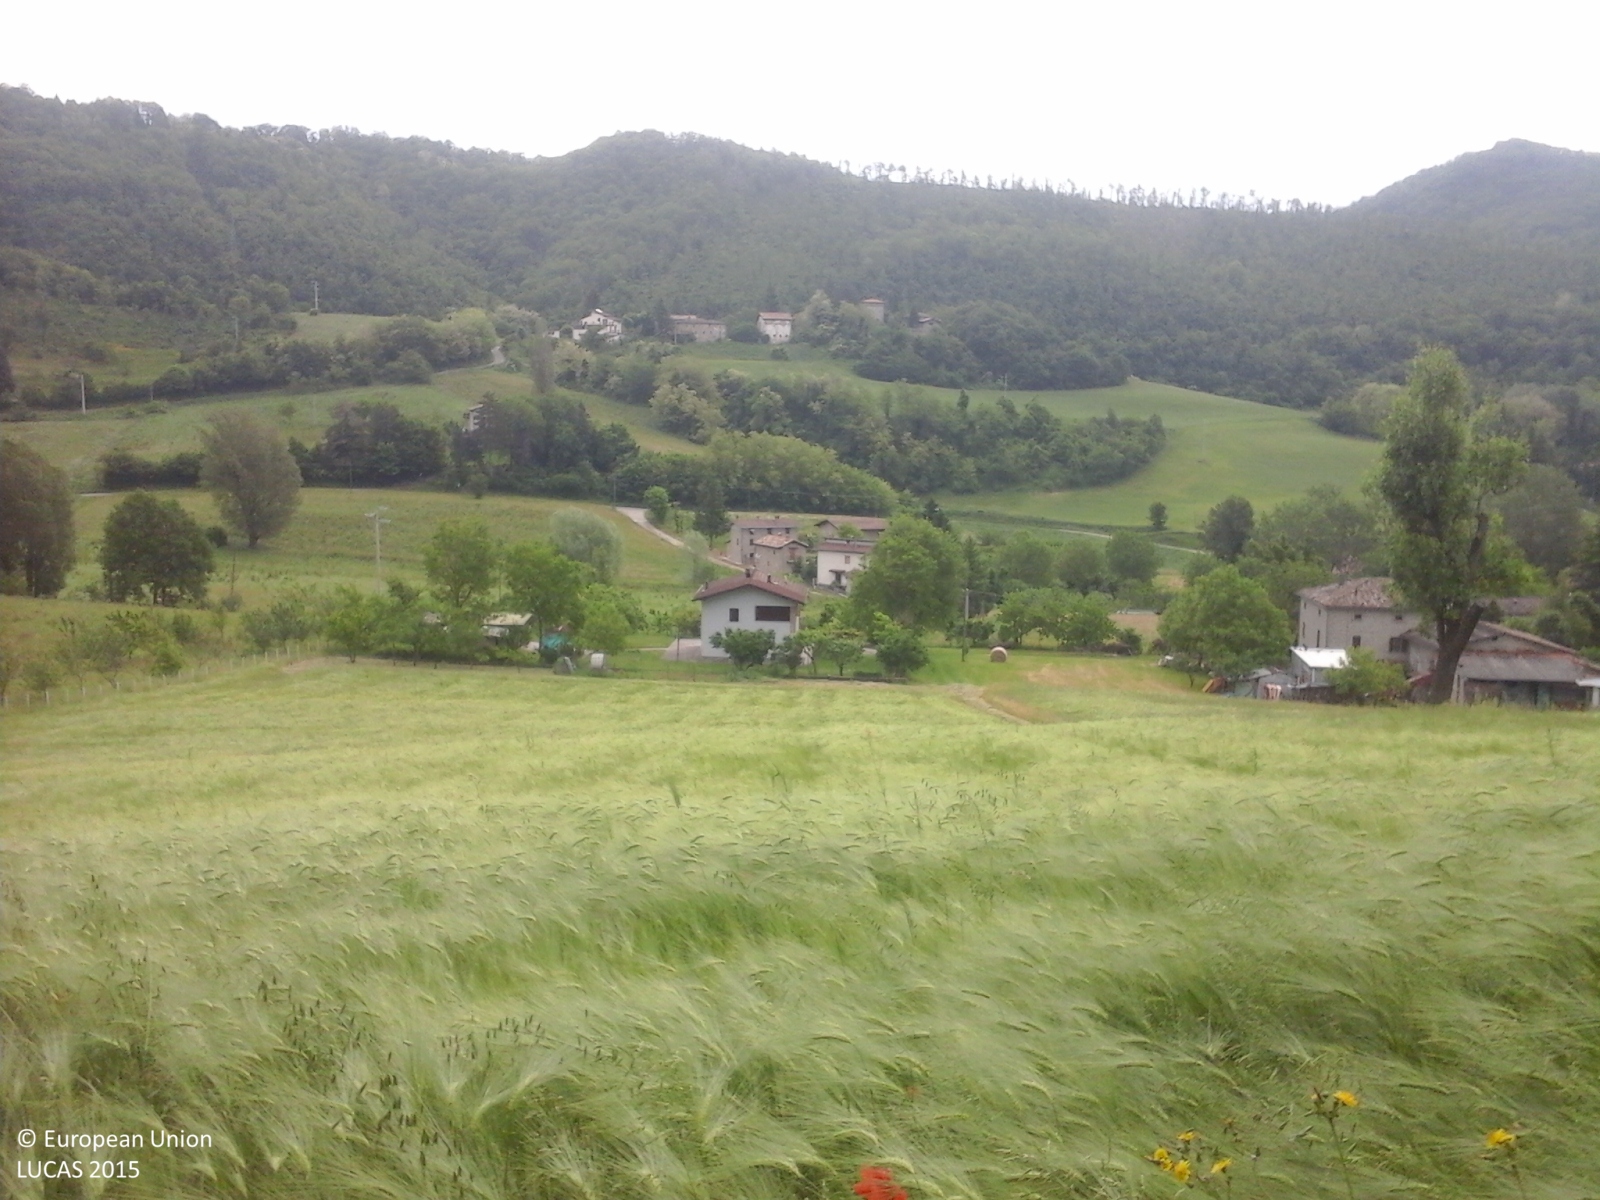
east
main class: Cropland
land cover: Barley
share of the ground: > 75 %
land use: Agriculture (excluding fallow land and kitchen gardens)
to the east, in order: Barley; Artificial constructions in urban areas; Grass margins; Ditches and canals; Spontaneously vegetated surfaces; Single bushes/trees; Lucerne
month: May
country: IT
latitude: 44.3100
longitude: 10.9631
